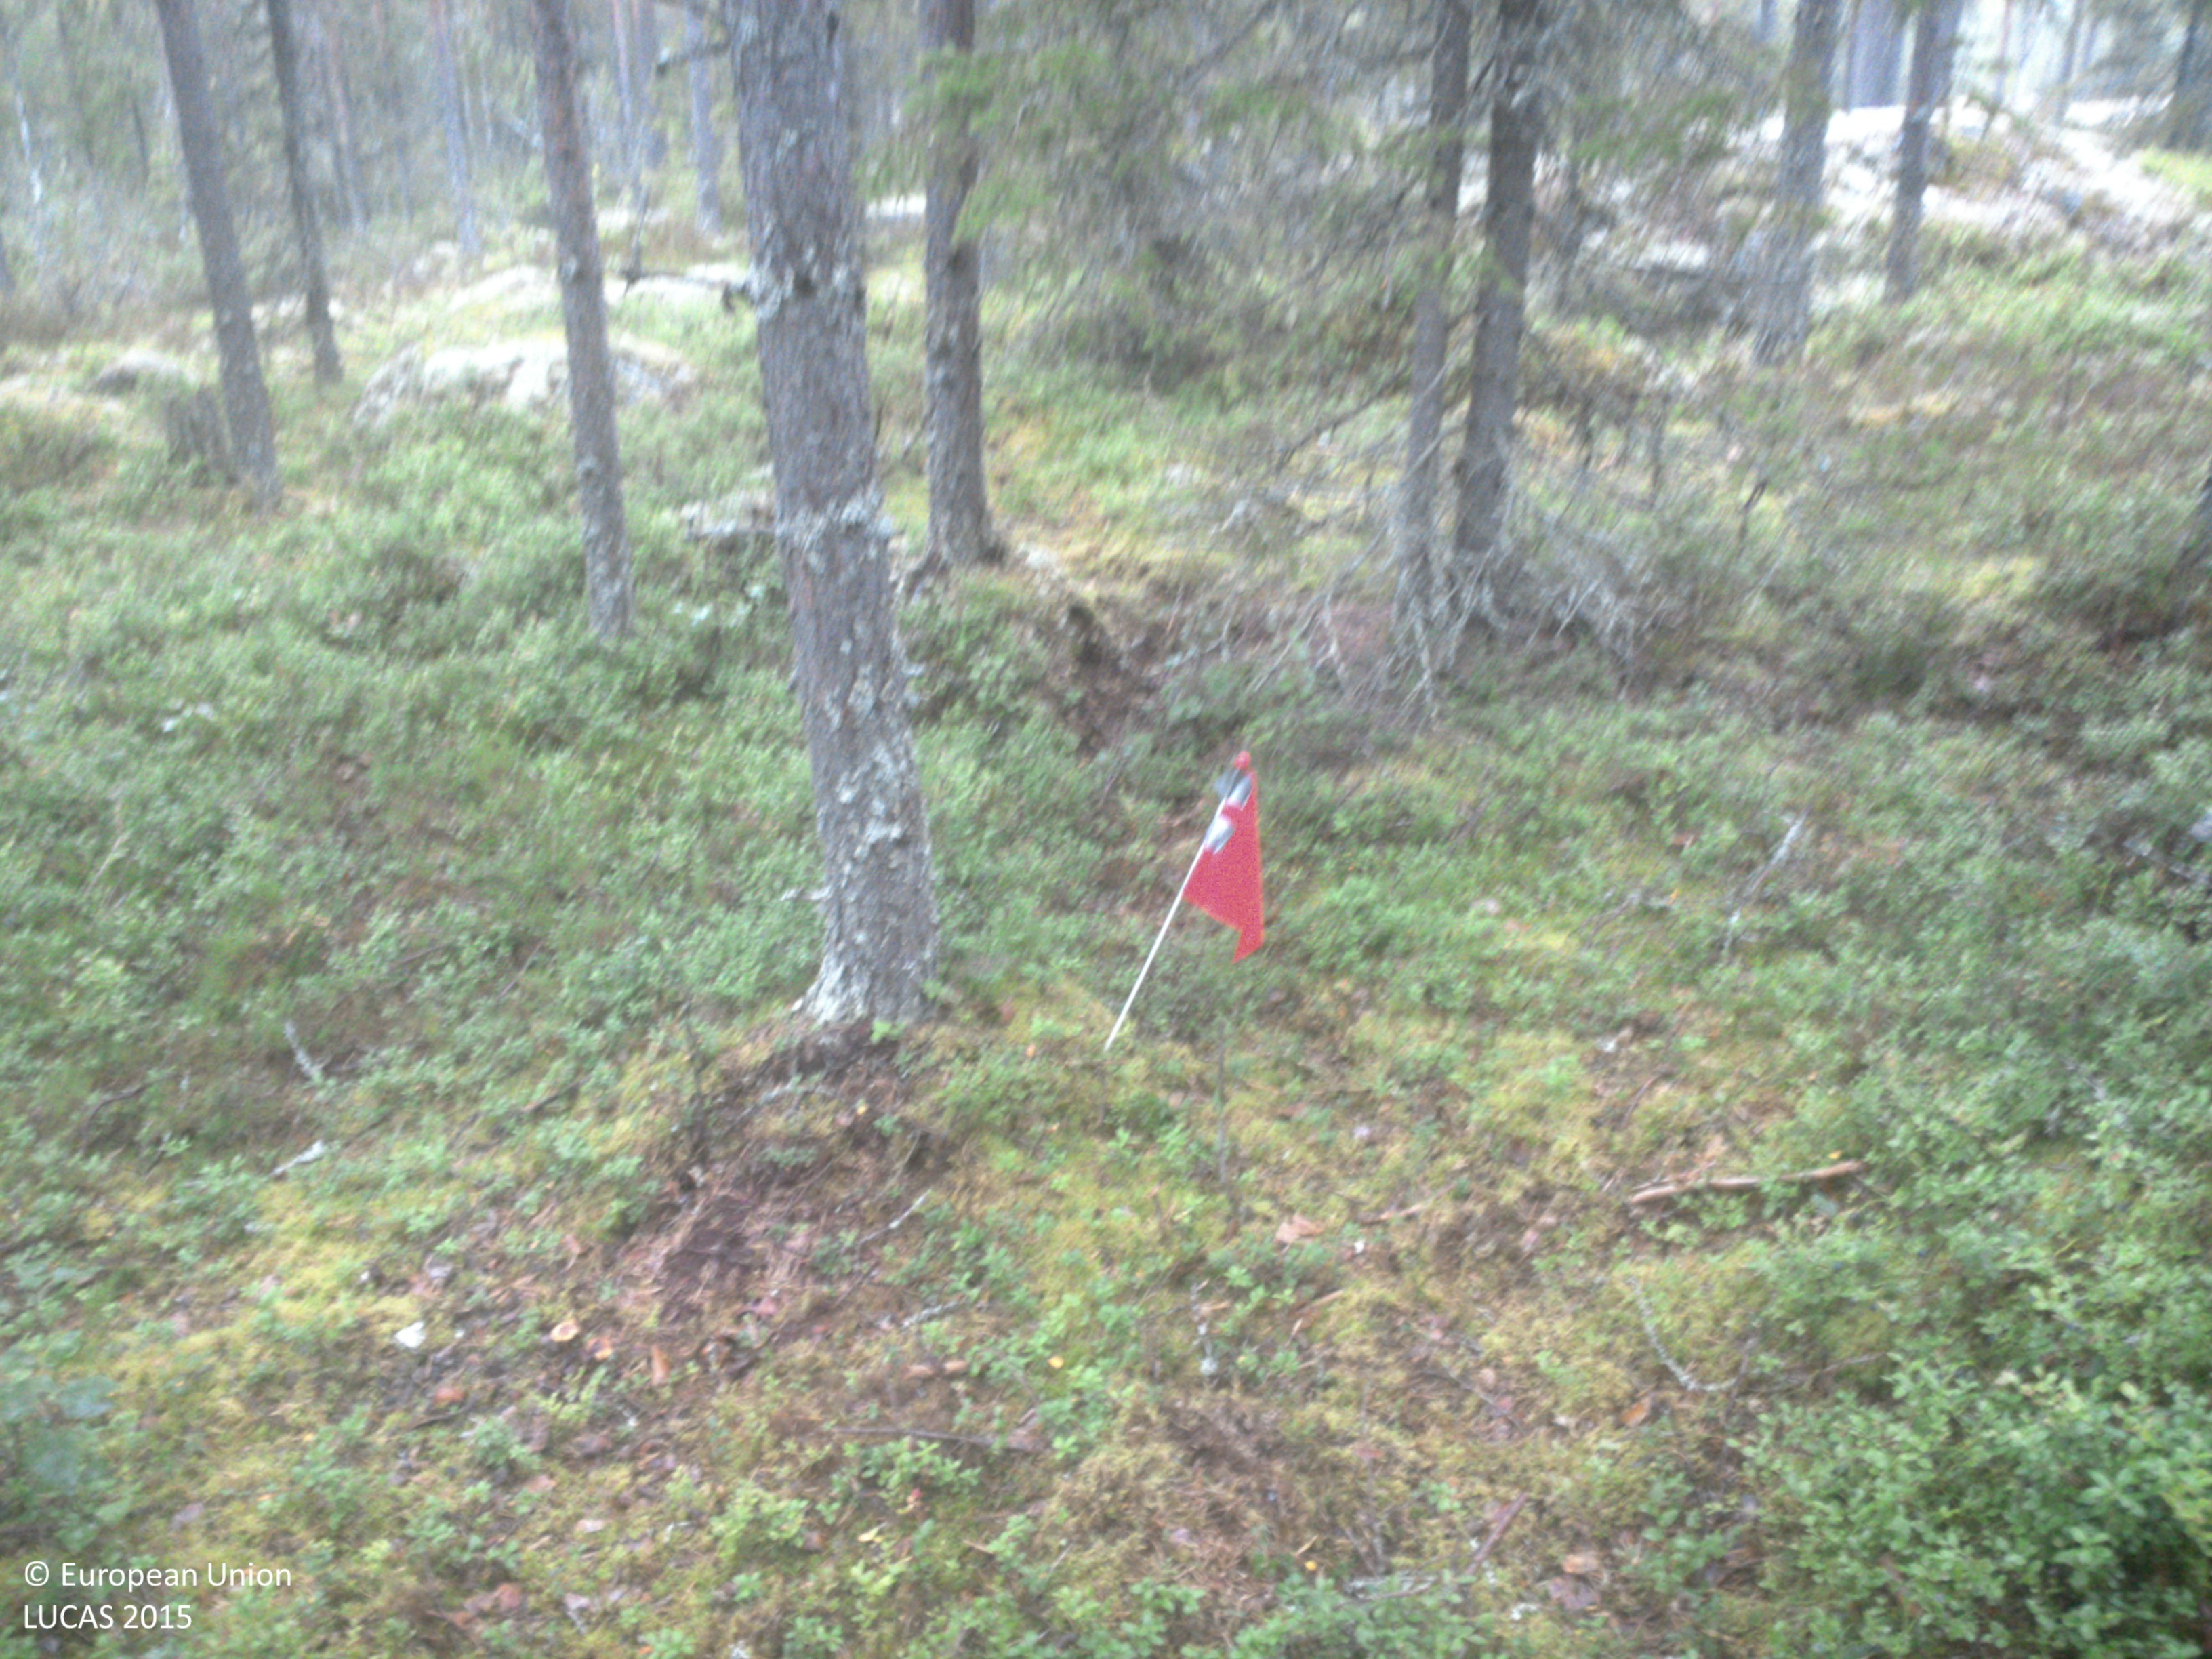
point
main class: Woodland
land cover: Other coniferous woodland
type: boreal forest
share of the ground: 50 - 75 %
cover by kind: coniferous forest trees 50 %, shrubs 50 %
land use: Forestry
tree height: > 5 m
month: August
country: SE
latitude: 63.7021
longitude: 19.9547
